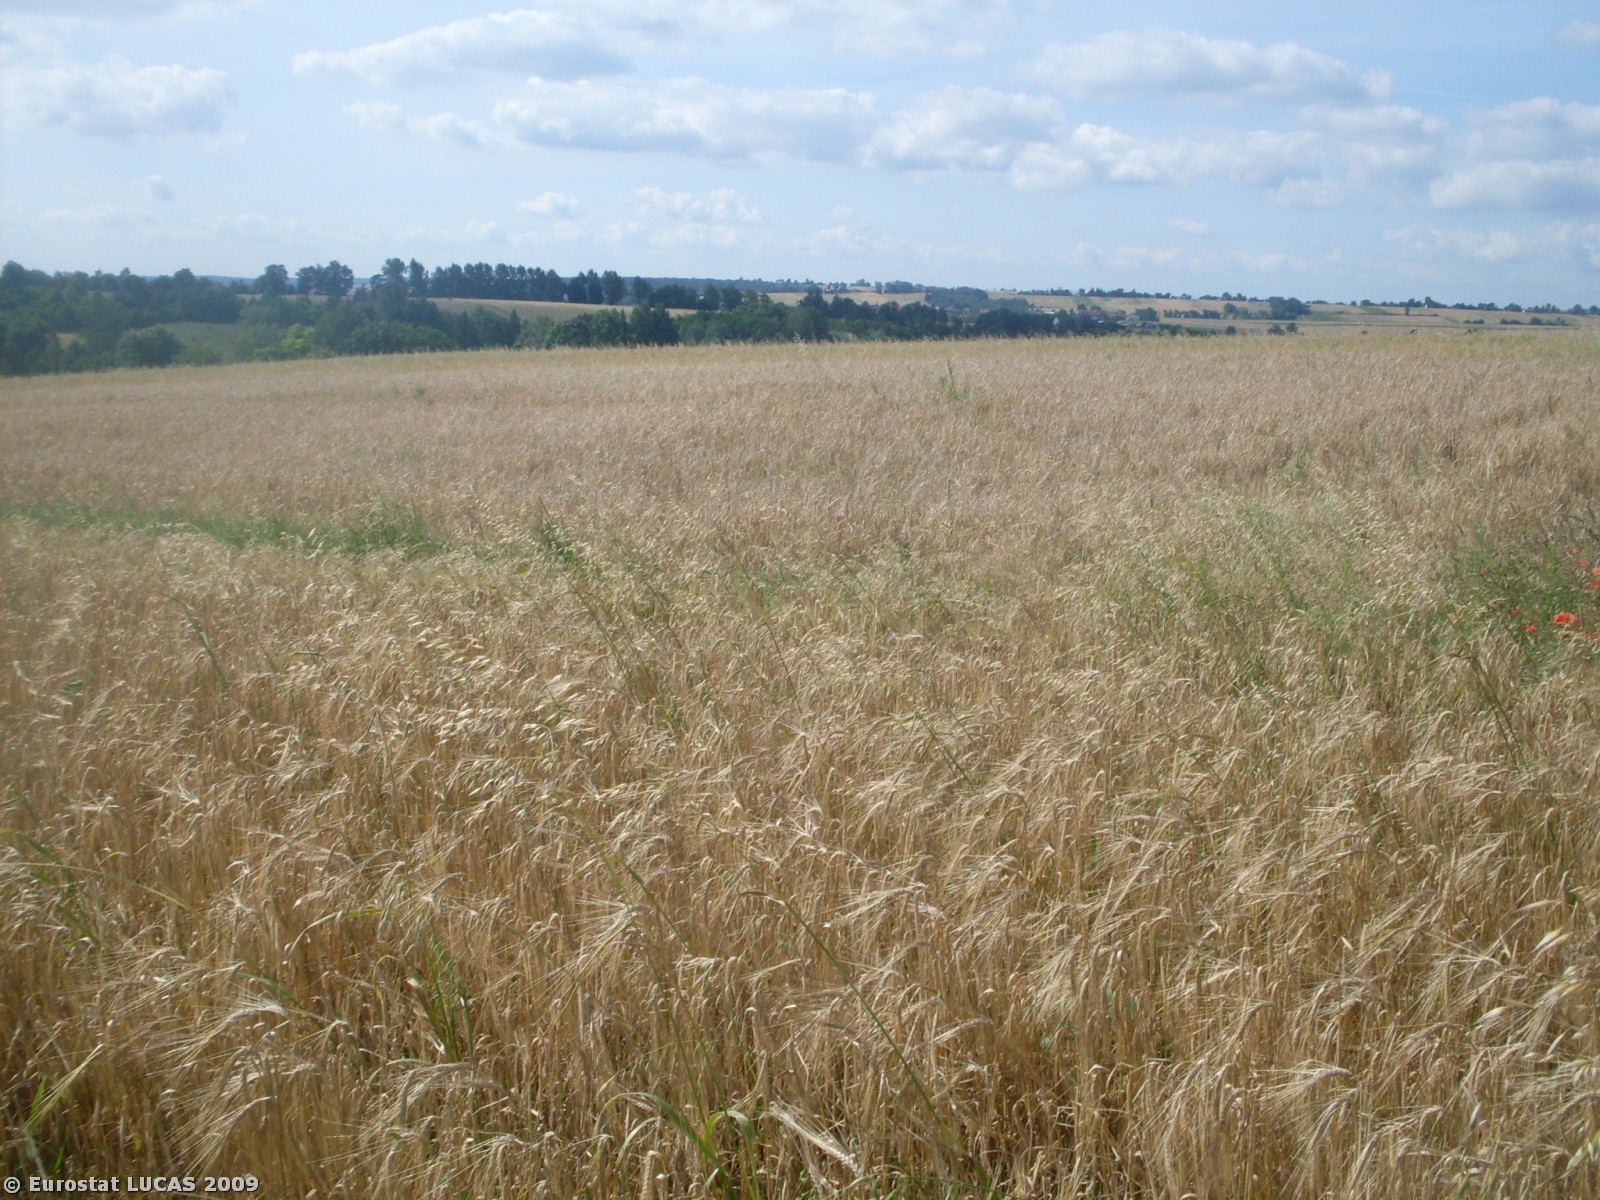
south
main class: Cropland
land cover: Mixed cereals for fodder
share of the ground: > 75 %
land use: Agriculture (excluding fallow land and kitchen gardens)
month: July
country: PL
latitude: 50.3015
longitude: 20.0429
